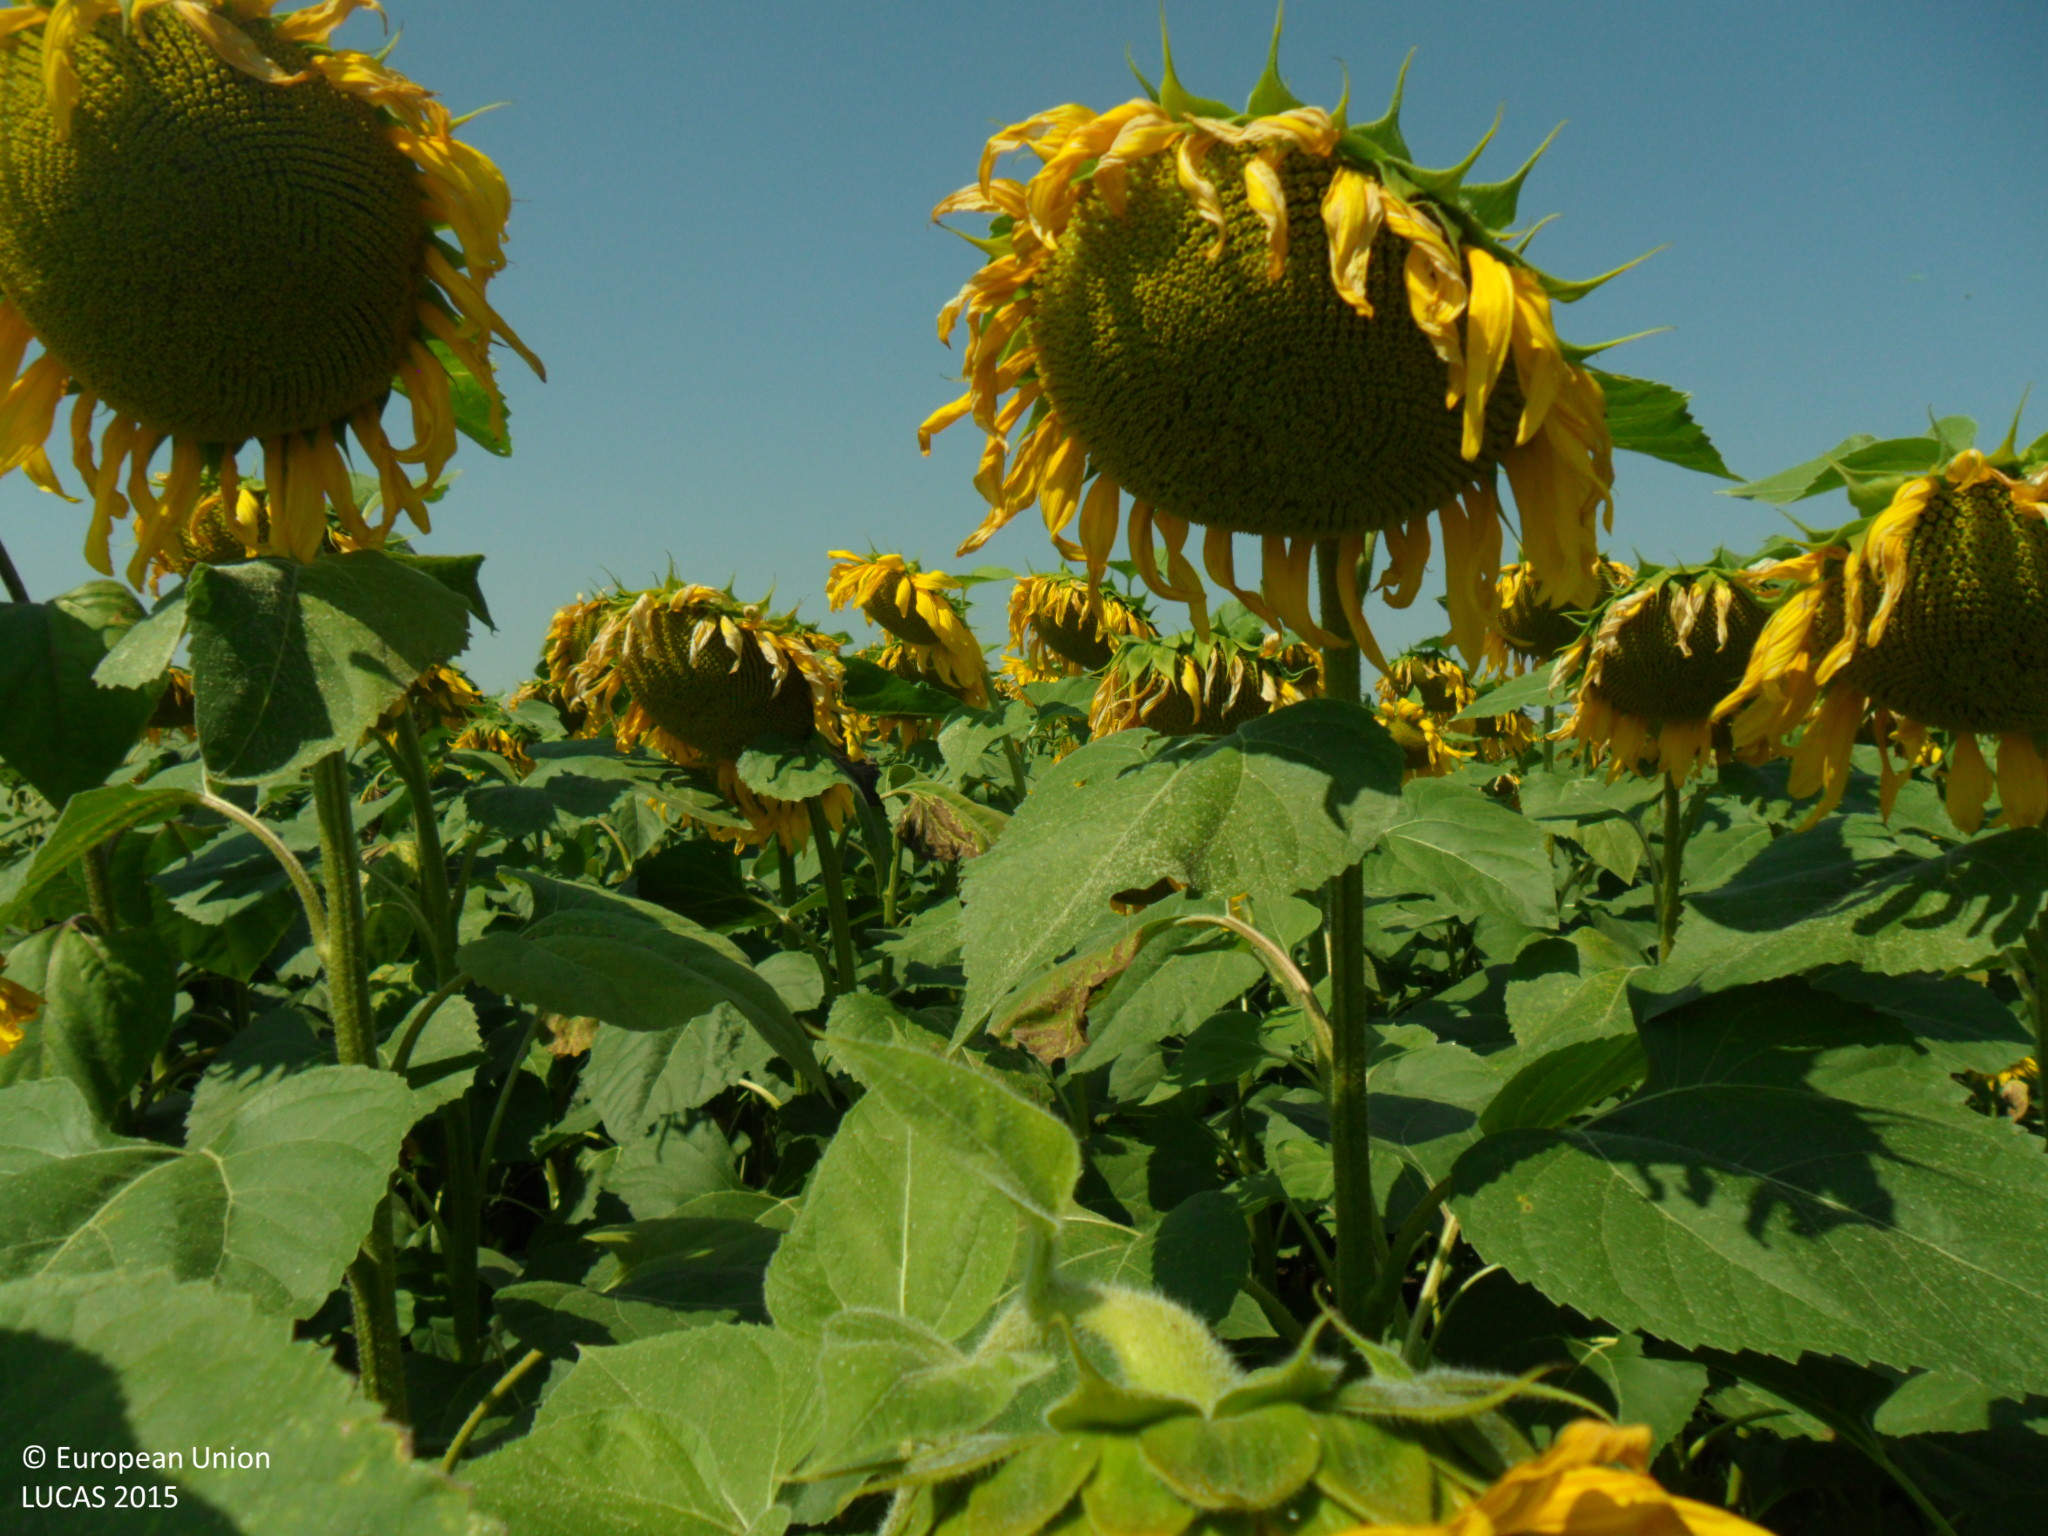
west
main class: Cropland
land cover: Sunflower
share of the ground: > 75 %
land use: Agriculture (excluding fallow land and kitchen gardens)
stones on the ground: < 10 %
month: July
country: BG
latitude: 43.8648
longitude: 26.4957
